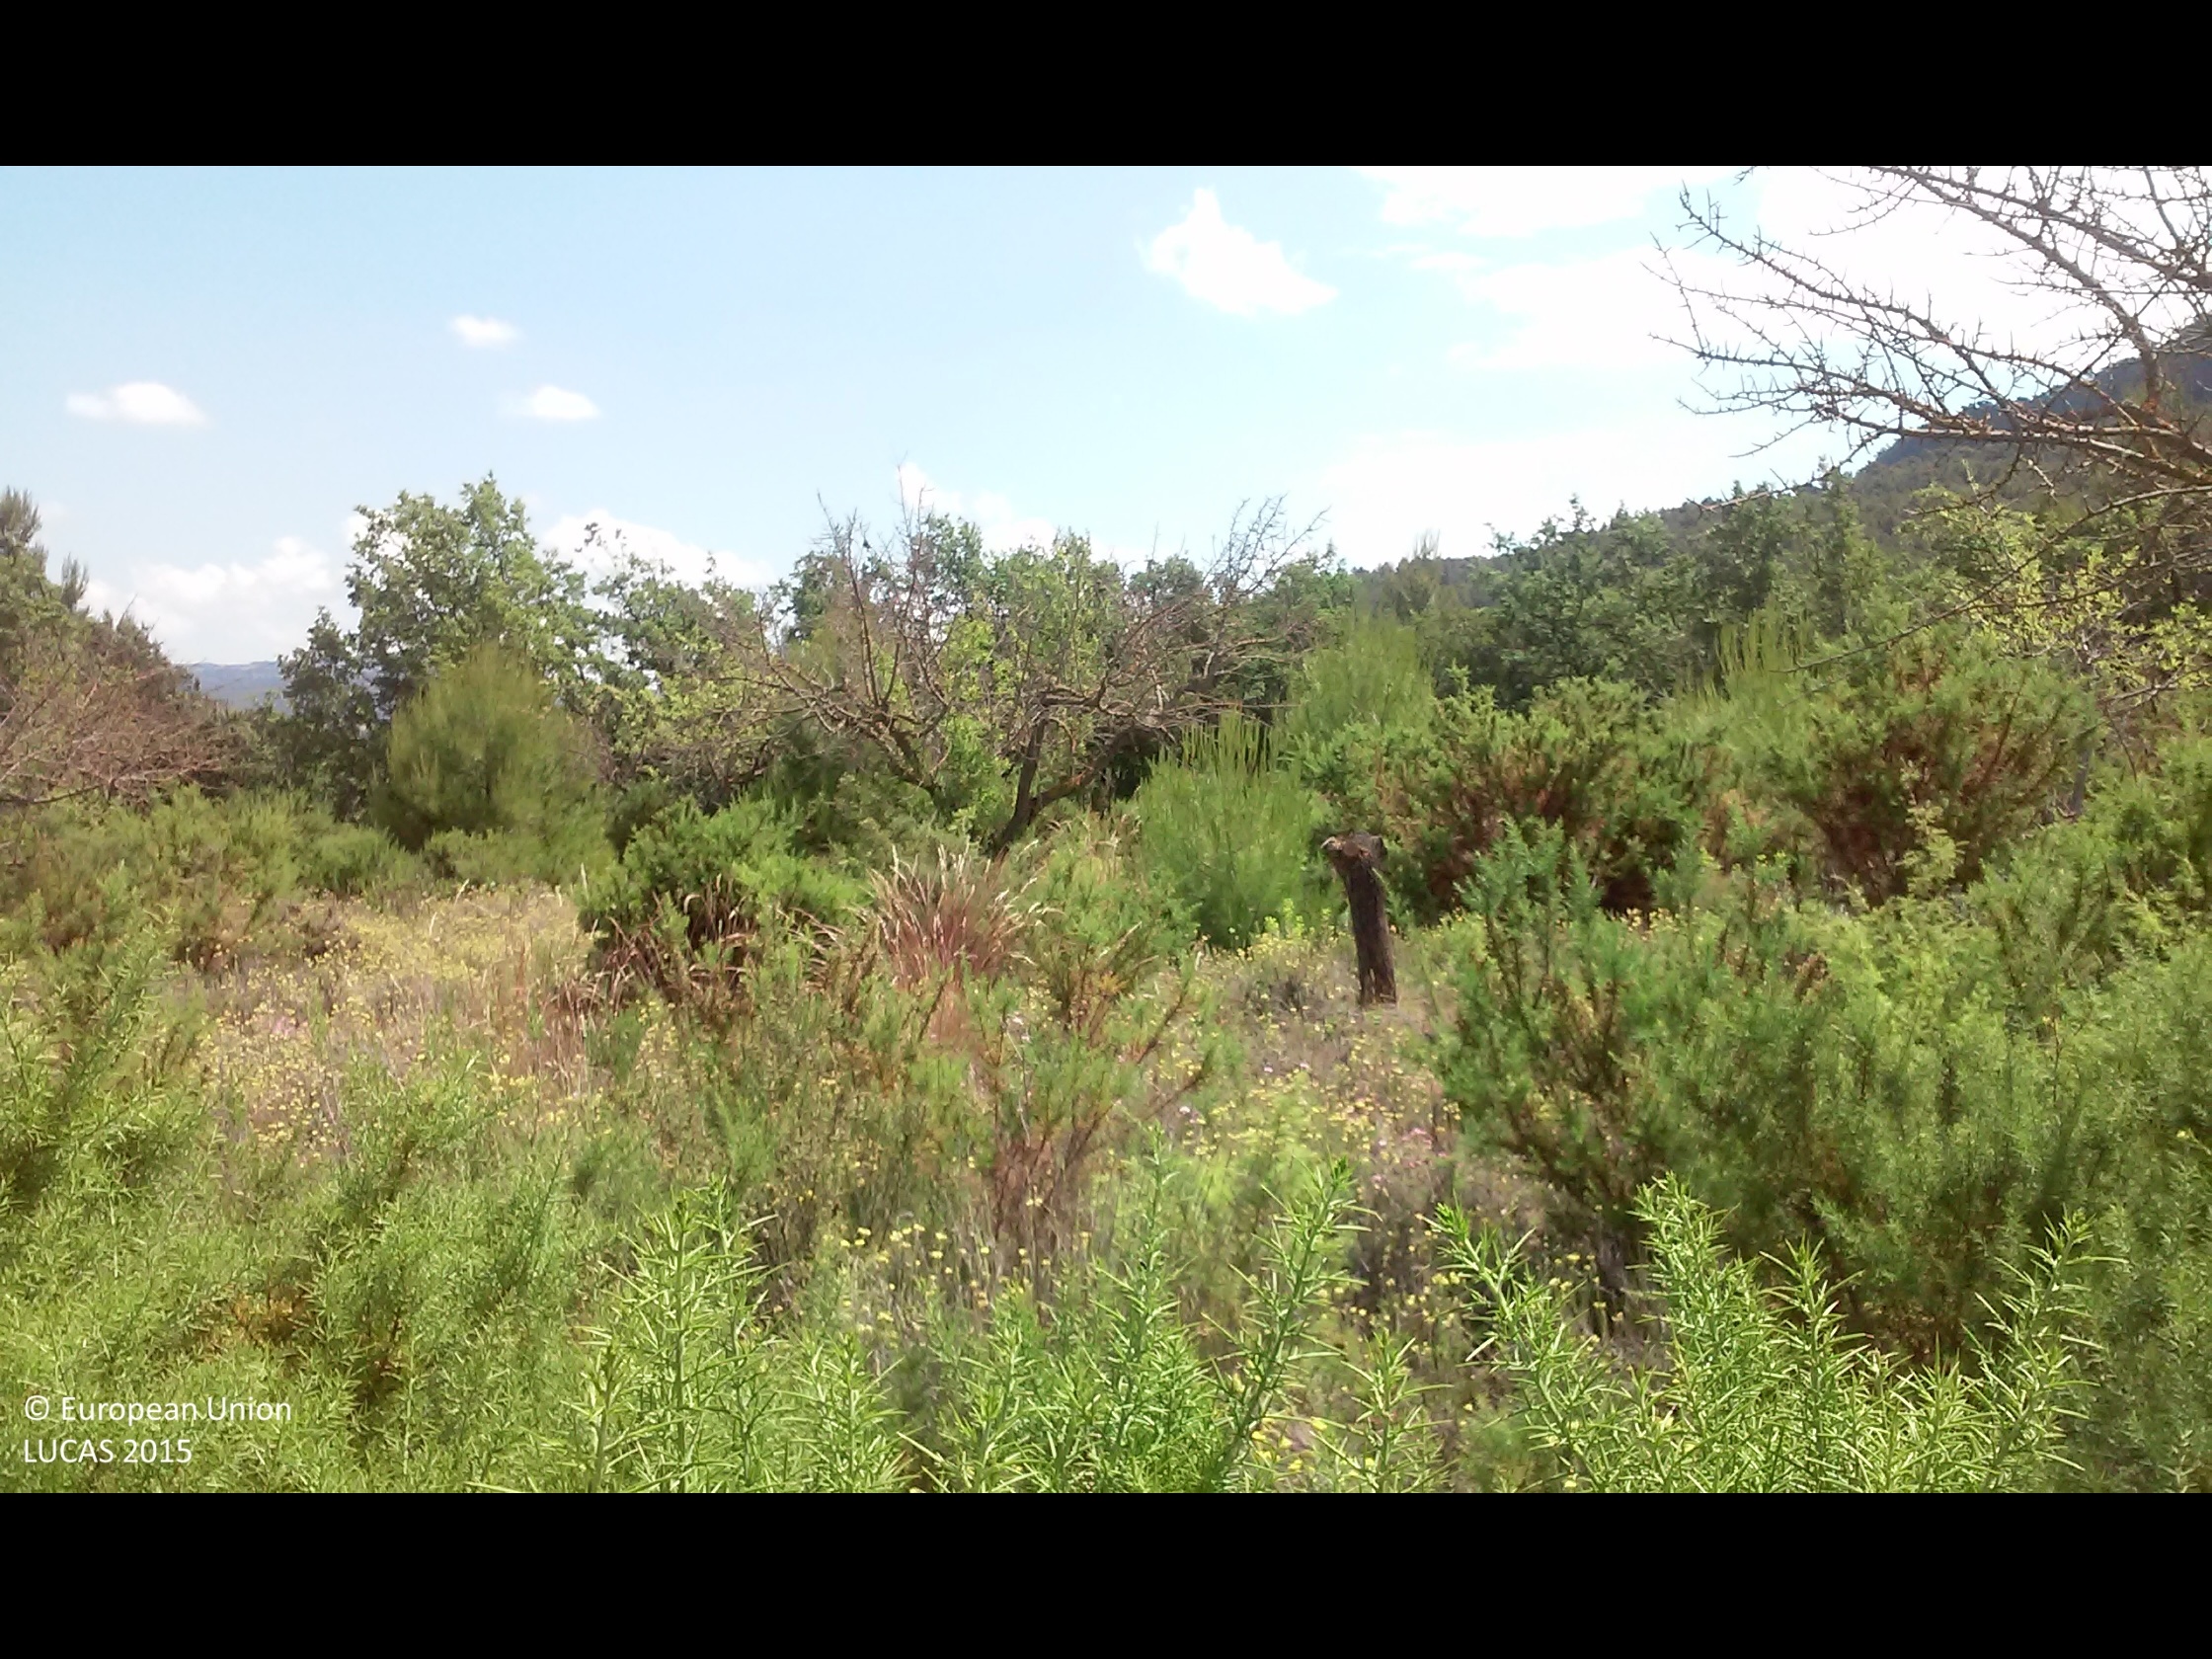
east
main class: Shrubland
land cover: Shrubland with sparse tree cover
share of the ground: 50 - 75 %
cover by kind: shrubs 70 %, herbaceous plants 20 %, broadleaved forest trees 5 %, consolidated bare surface 5 %
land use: Abandoned areas
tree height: < 5 m
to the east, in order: Shrubland with sparse tree cover; Pine dominated coniferous woodland; Shrubland with sparse tree cover
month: June
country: ES
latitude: 41.3827
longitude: 1.2267
